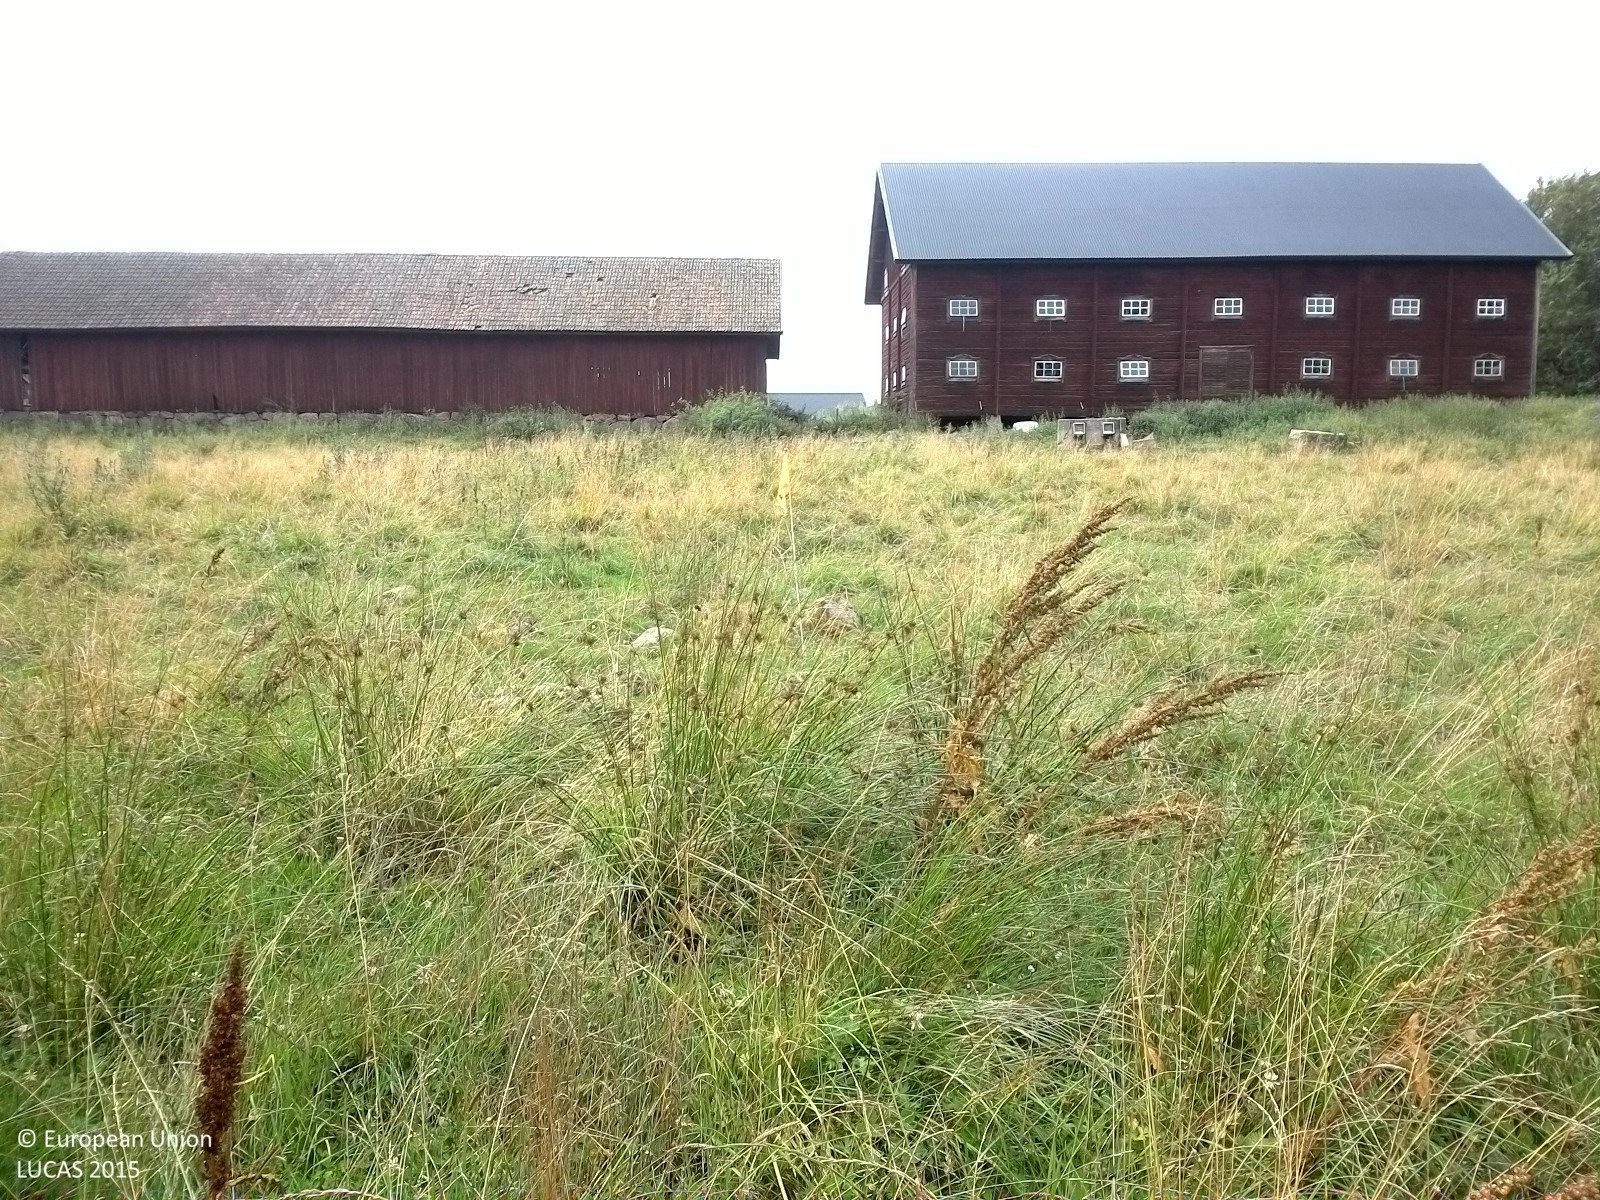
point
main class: Grassland
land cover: Grassland without tree/shrub cover
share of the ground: > 75 %
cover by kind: herbaceous plants 100 %
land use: Agriculture (excluding fallow land and kitchen gardens)
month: August
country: SE
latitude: 59.1204
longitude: 14.9356
